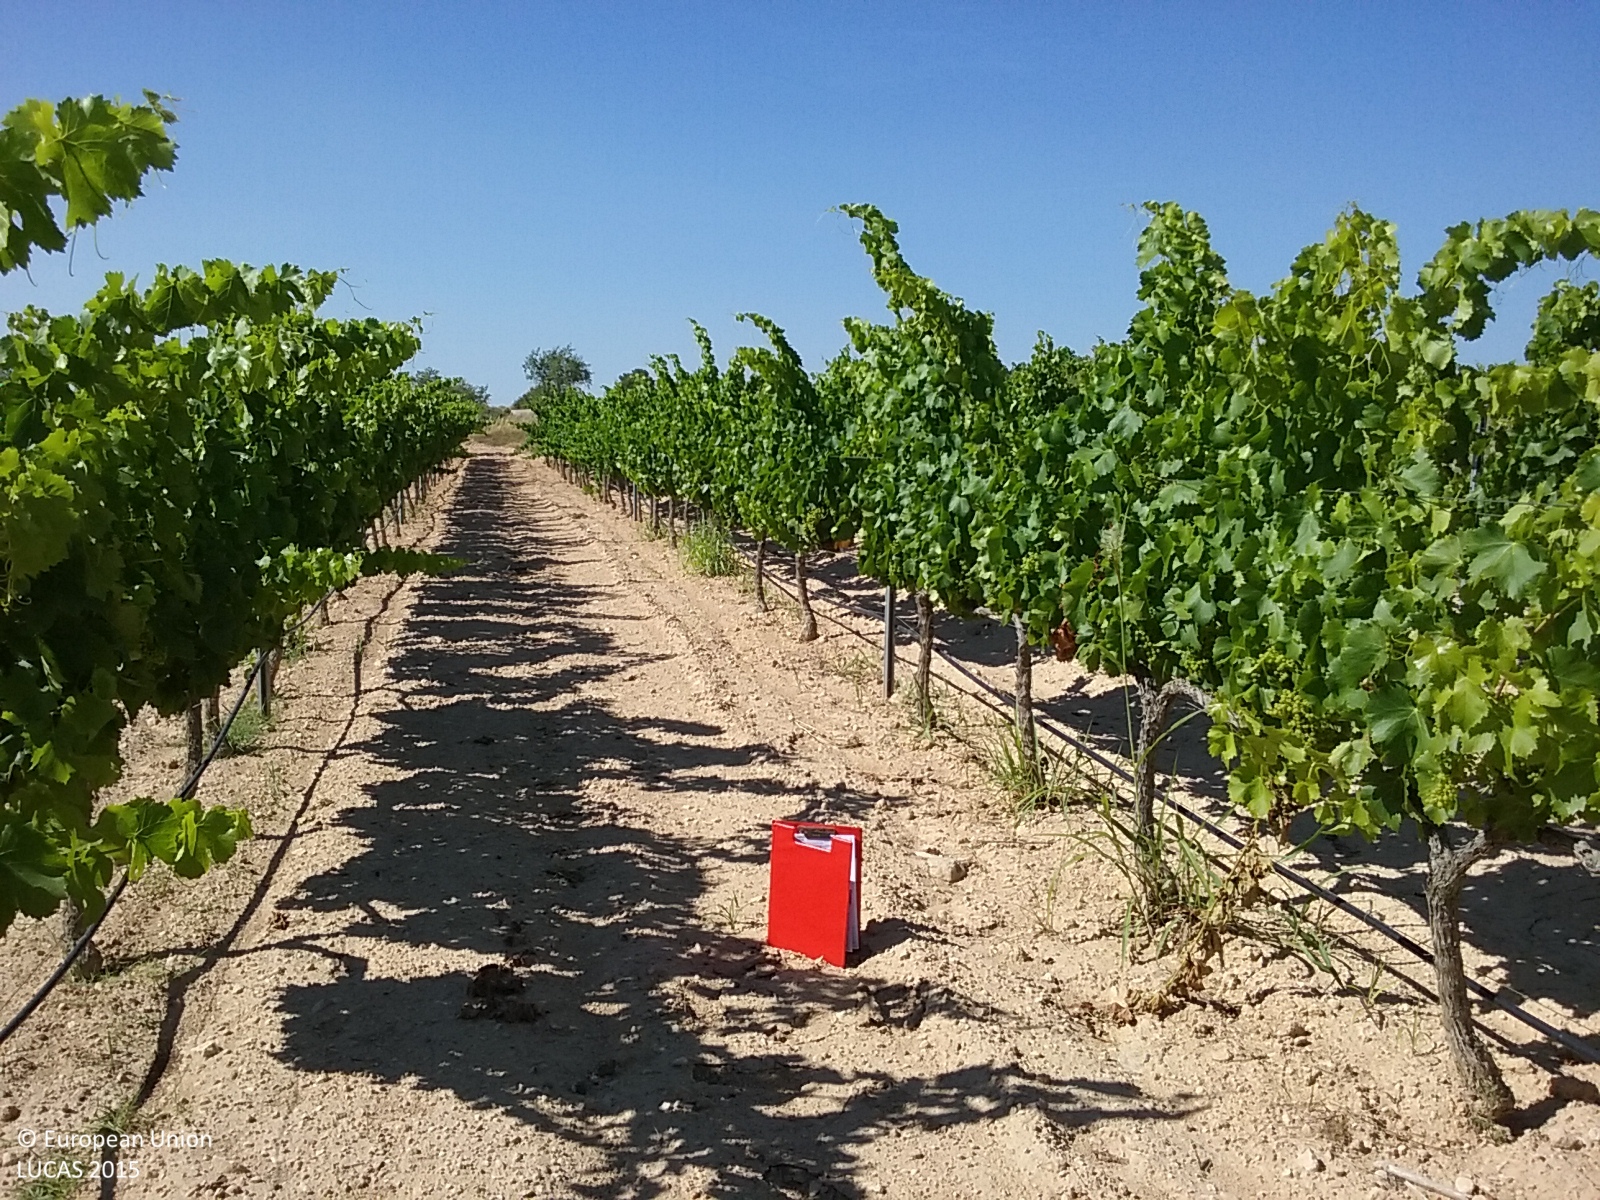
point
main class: Cropland
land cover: Vineyards
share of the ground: 10 - 25 %
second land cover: Other bare soil
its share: > 75 %
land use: Agriculture (excluding fallow land and kitchen gardens)
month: June
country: ES
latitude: 41.1060
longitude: 0.2138
